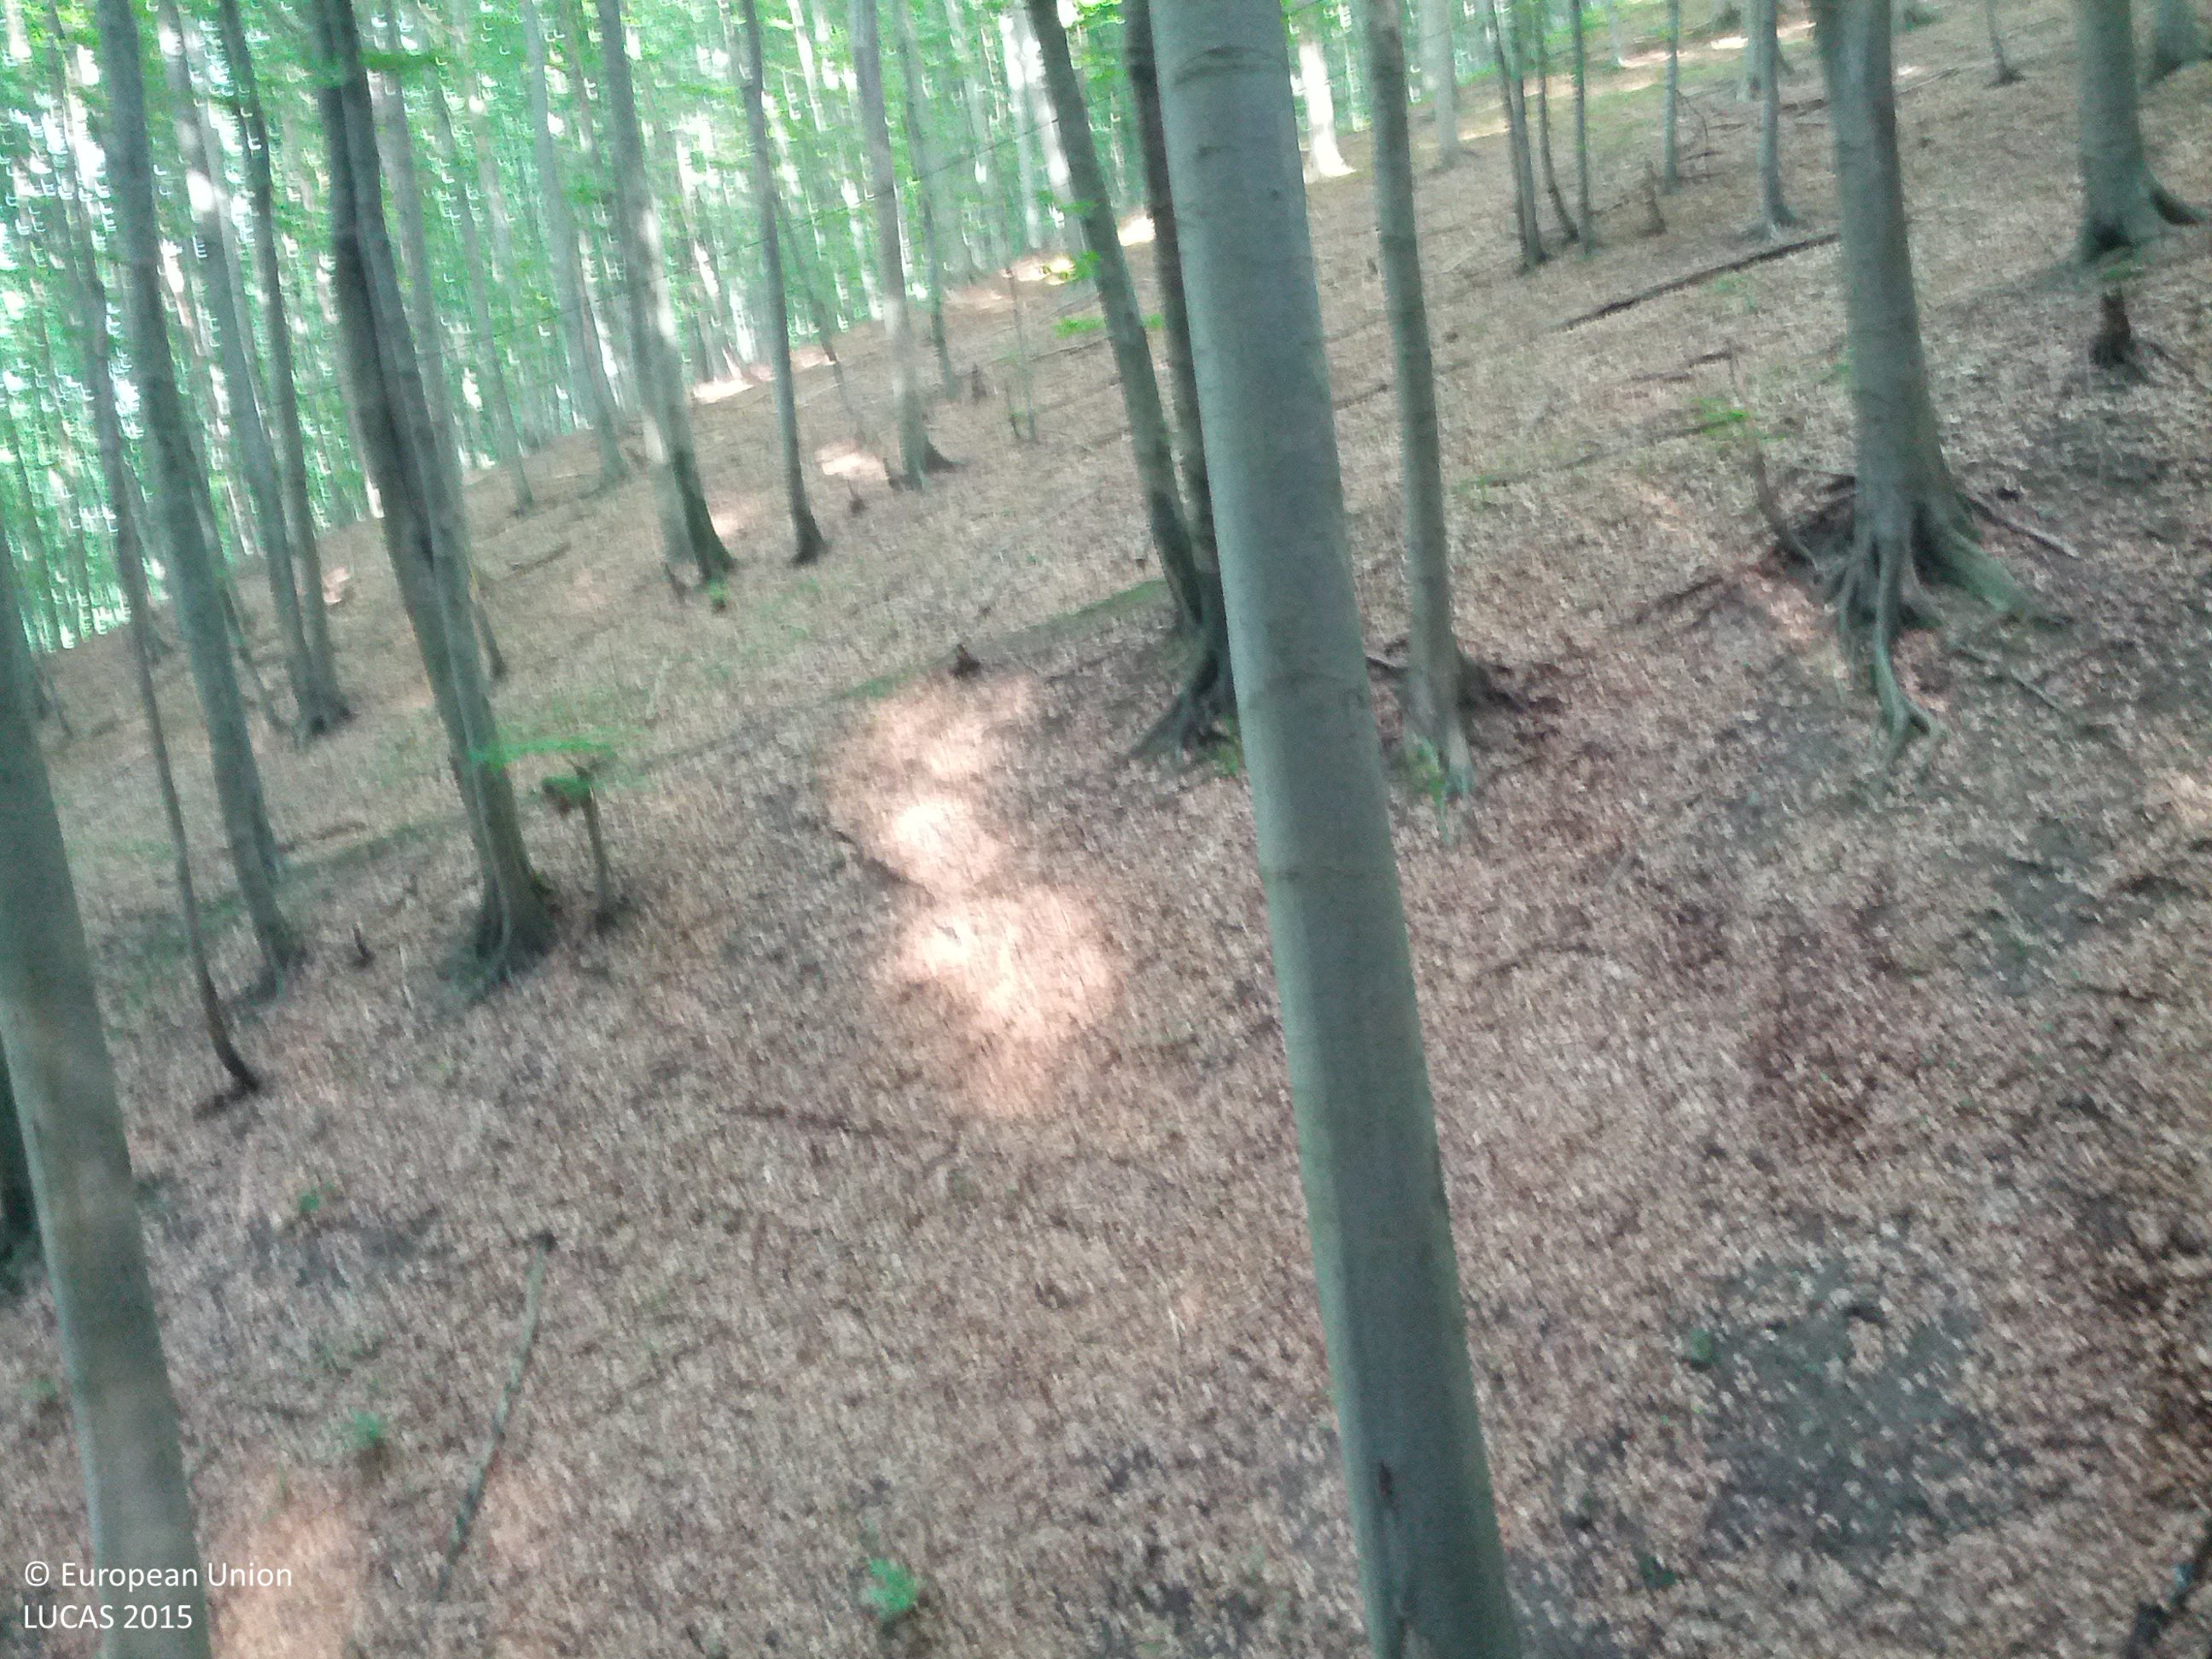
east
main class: Woodland
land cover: Broadleaved woodland
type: beech forest
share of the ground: > 75 %
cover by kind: broadleaved forest trees 95 %, herbaceous plants 5 %
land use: Forestry
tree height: > 5 m
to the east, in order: Broadleaved woodland; Rivers and streams; Broadleaved woodland; Electric lines; Broadleaved woodland
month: May
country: AT
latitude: 48.2632
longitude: 16.2418
